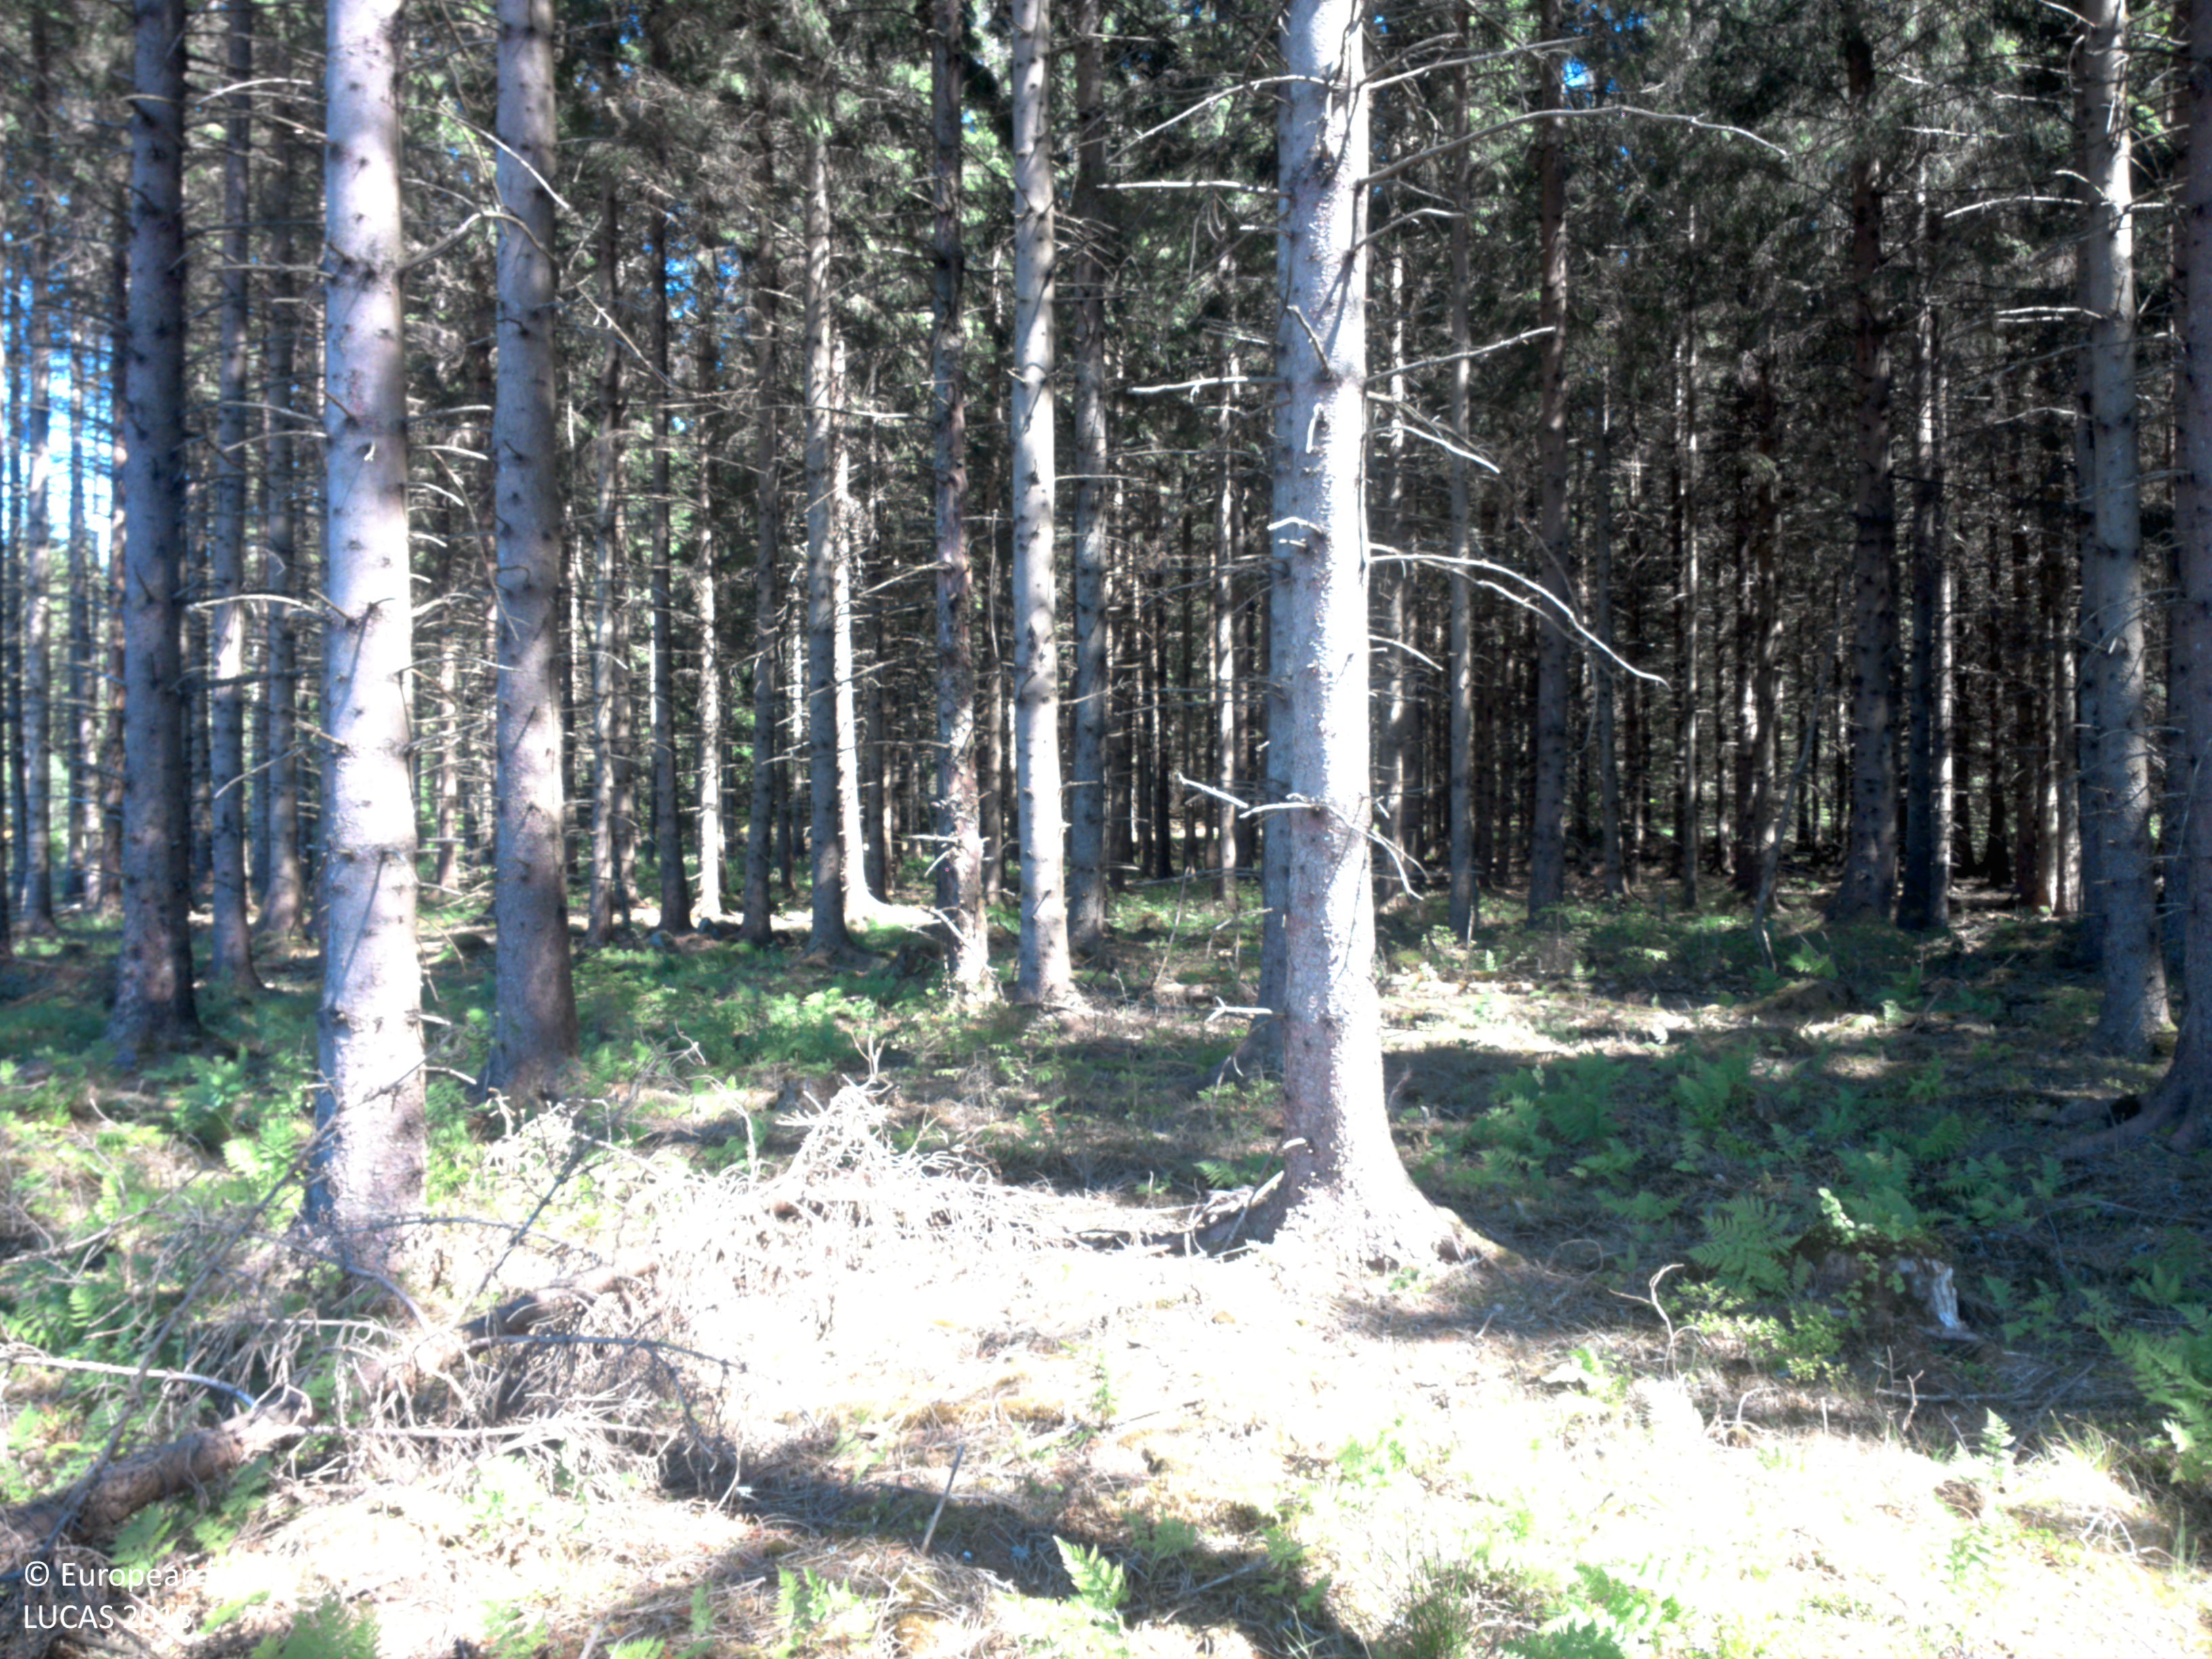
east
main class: Woodland
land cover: Spruce dominated coniferous woodland
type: boreal forest
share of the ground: 50 - 75 %
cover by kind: coniferous forest trees 50 %, lichens and mosses 50 %
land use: Forestry
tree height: > 5 m
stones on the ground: < 10 %
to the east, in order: Spruce dominated coniferous woodland; Ditches and canals; Spruce dominated coniferous woodland; Ditches and canals; Spruce dominated coniferous woodland; Tracks; Spruce dominated coniferous woodland; Ditches and canals; Spruce dominated coniferous woodland
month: July
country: SE
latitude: 58.4755
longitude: 11.9336
